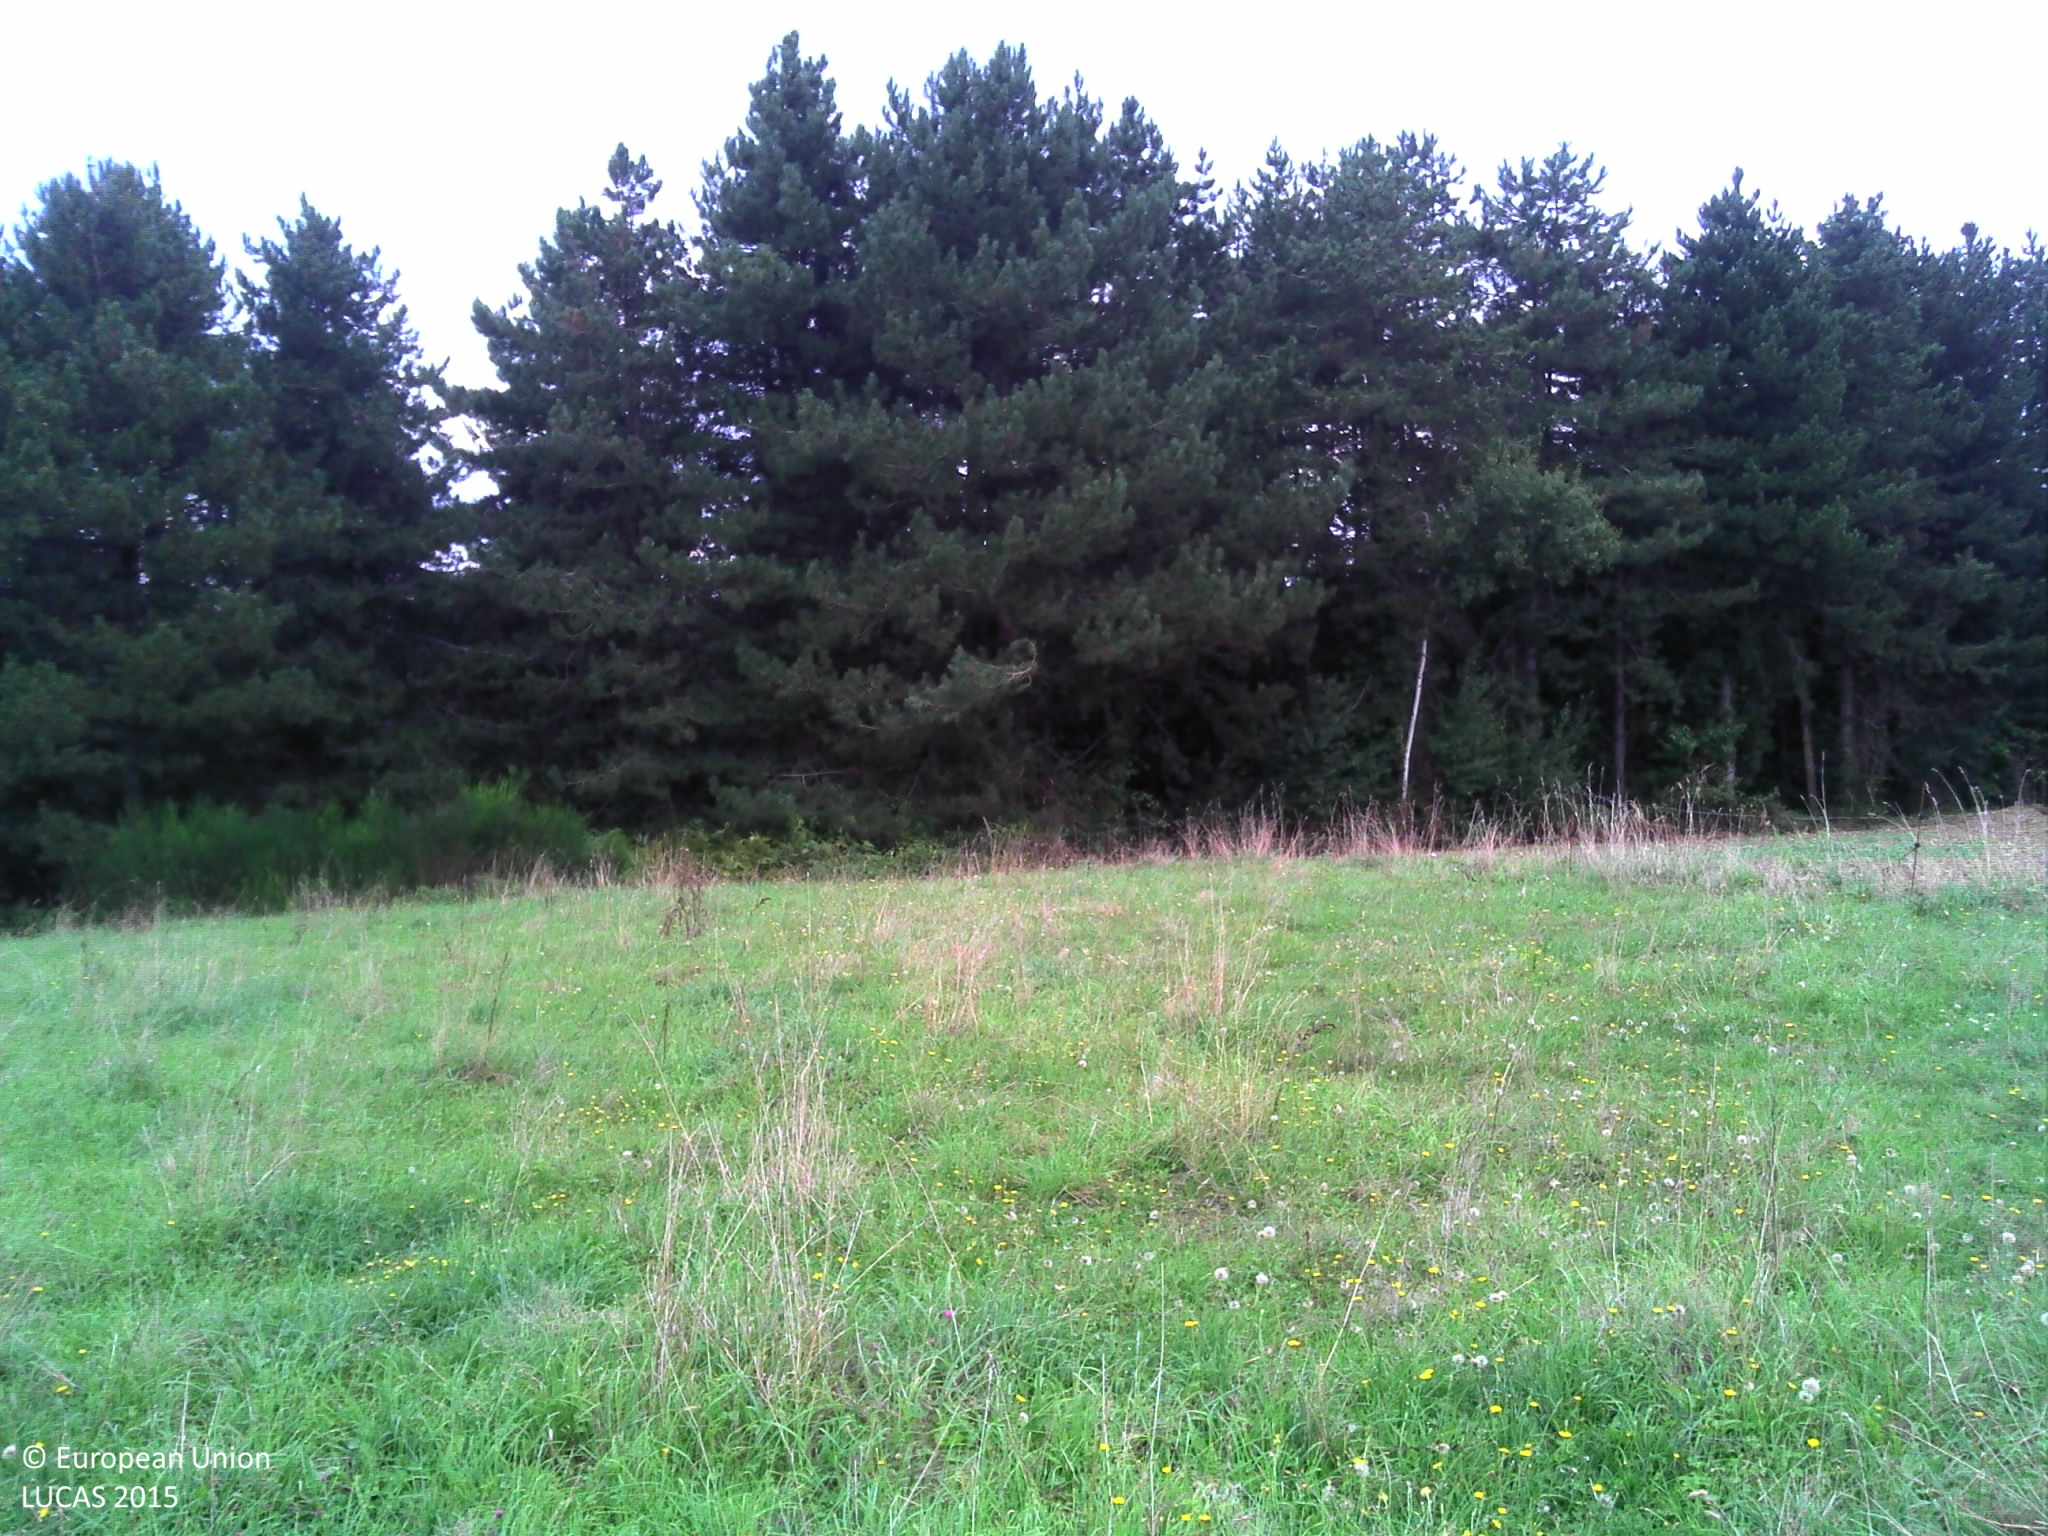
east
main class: Grassland
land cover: Grassland without tree/shrub cover
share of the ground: > 75 %
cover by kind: herbaceous plants 100 %
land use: Agriculture (excluding fallow land and kitchen gardens)
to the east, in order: Grassland without tree/shrub cover; Fences; Grass margins; Common wheat; Grass margins; Pine dominated coniferous woodland; Ditches and canals; Broadleaved woodland; Shrubland with sparse tree cover; Broadleaved woodland; Grassland without tree/shrub cover; Shrubland without tree cover; Rivers and streams; Shruby margins; Fences; Grassland without tree/shrub cover; Shrubland with sparse tree cover
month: September
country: FR
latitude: 43.4136
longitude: -0.1700
